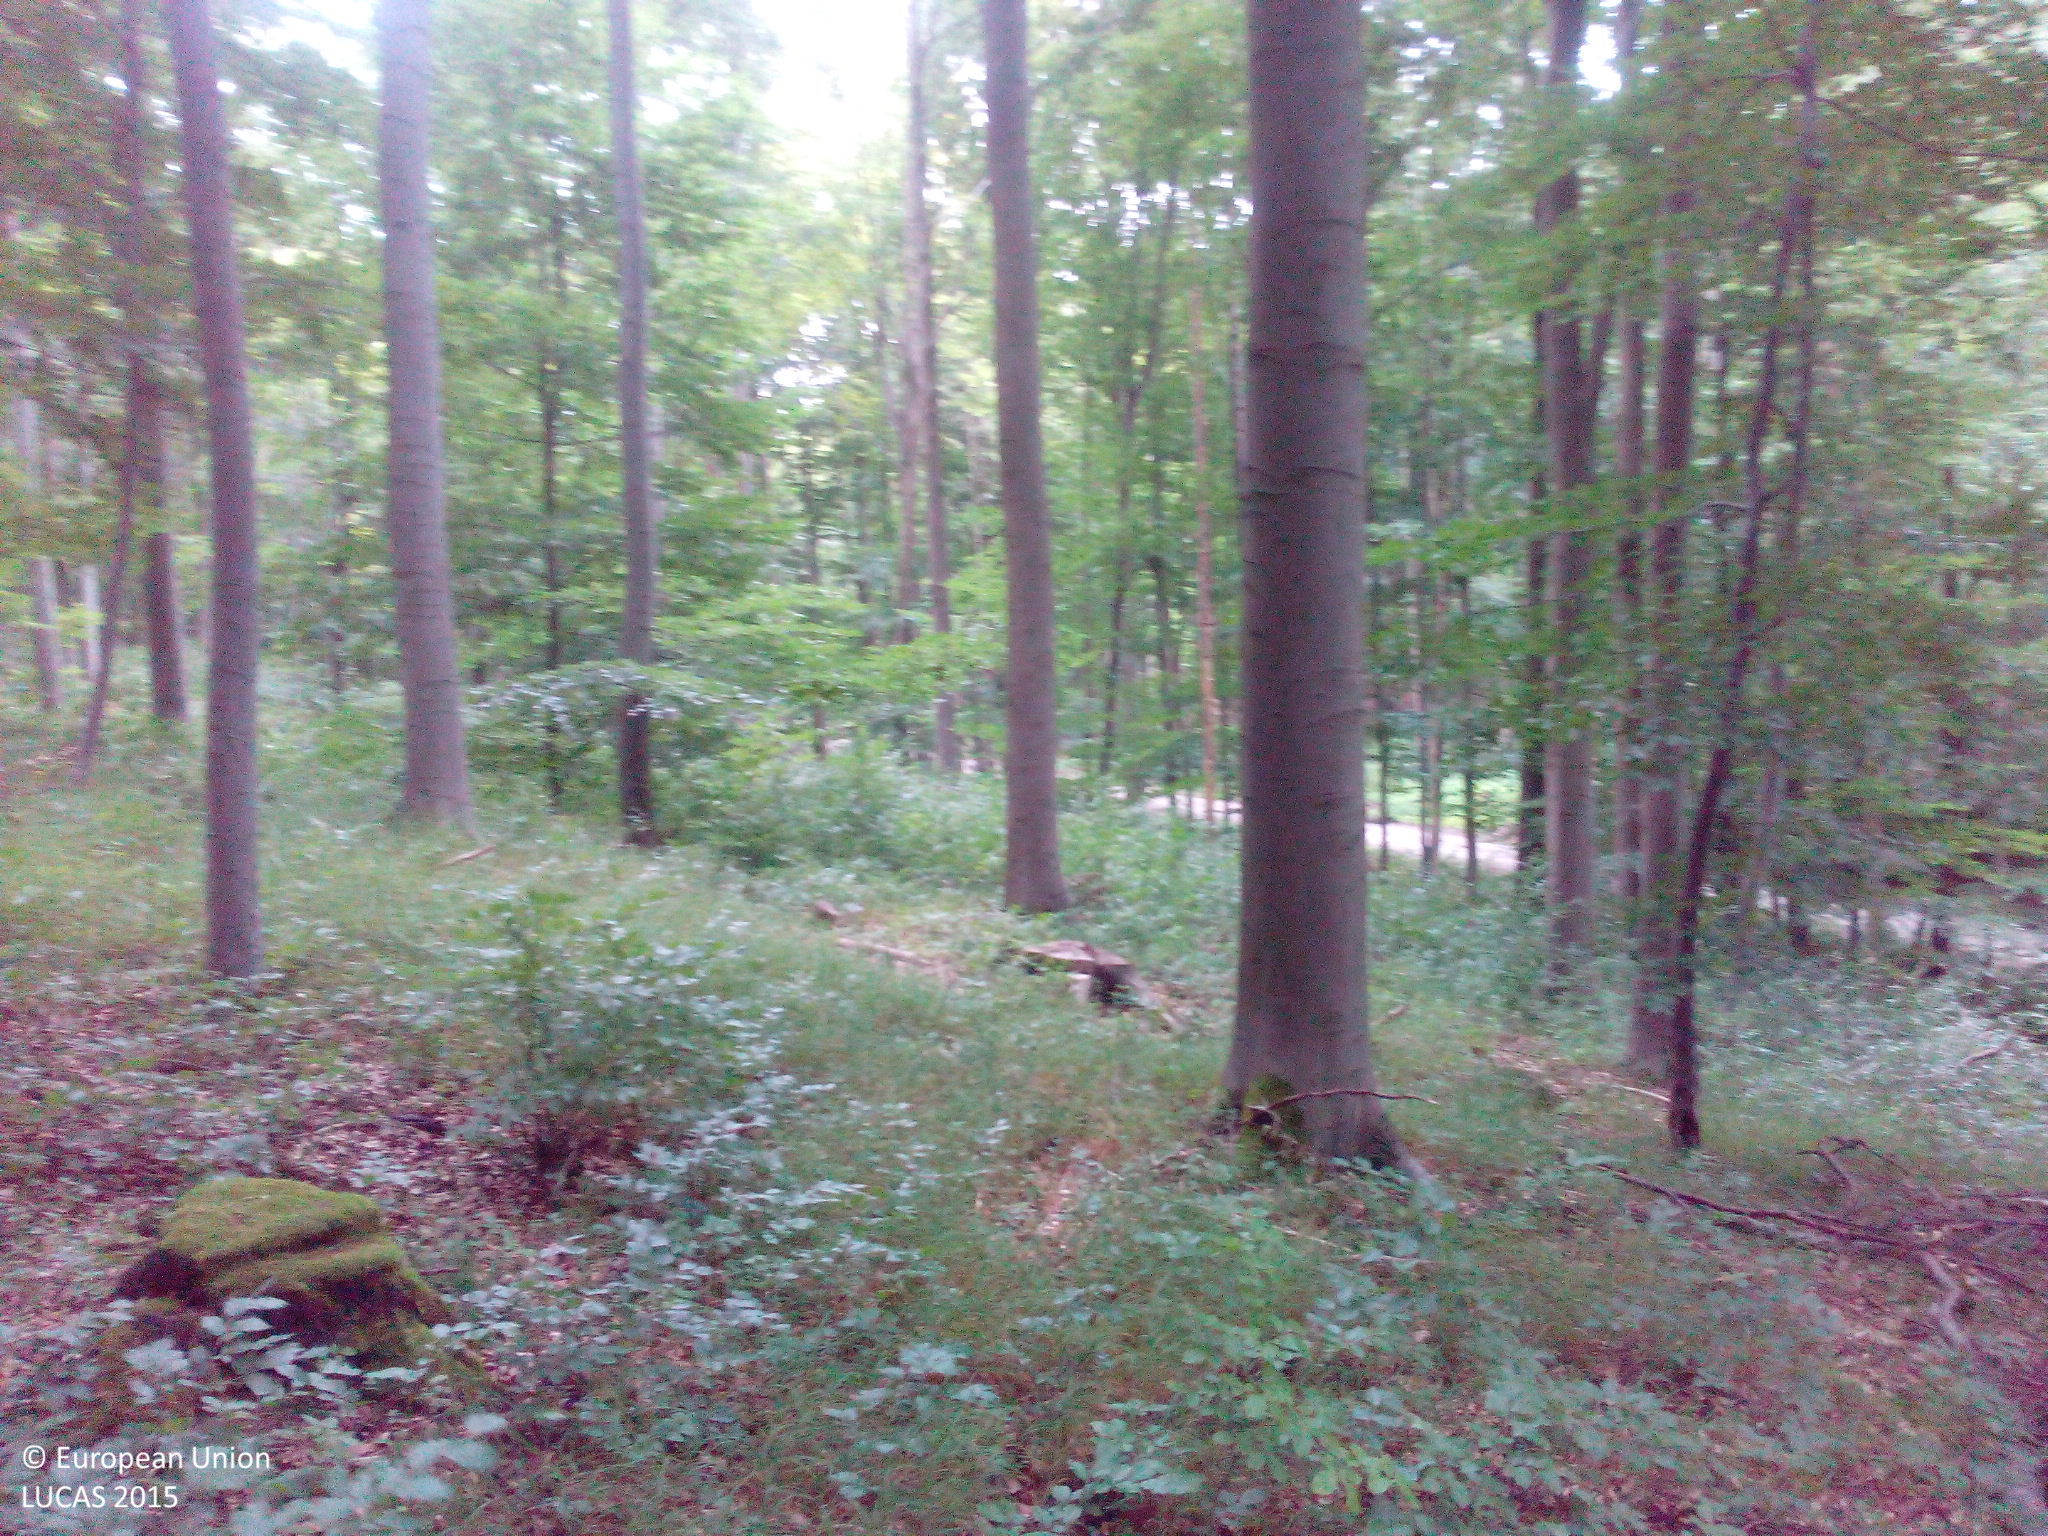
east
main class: Woodland
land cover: Broadleaved woodland
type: beech forest
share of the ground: > 75 %
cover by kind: broadleaved forest trees 95 %, herbaceous plants 5 %
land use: Forestry
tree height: > 5 m
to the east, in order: Broadleaved woodland; Ditches and canals; Tracks; Ditches and canals; Broadleaved woodland
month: July
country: DE
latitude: 51.4047
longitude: 9.2958
